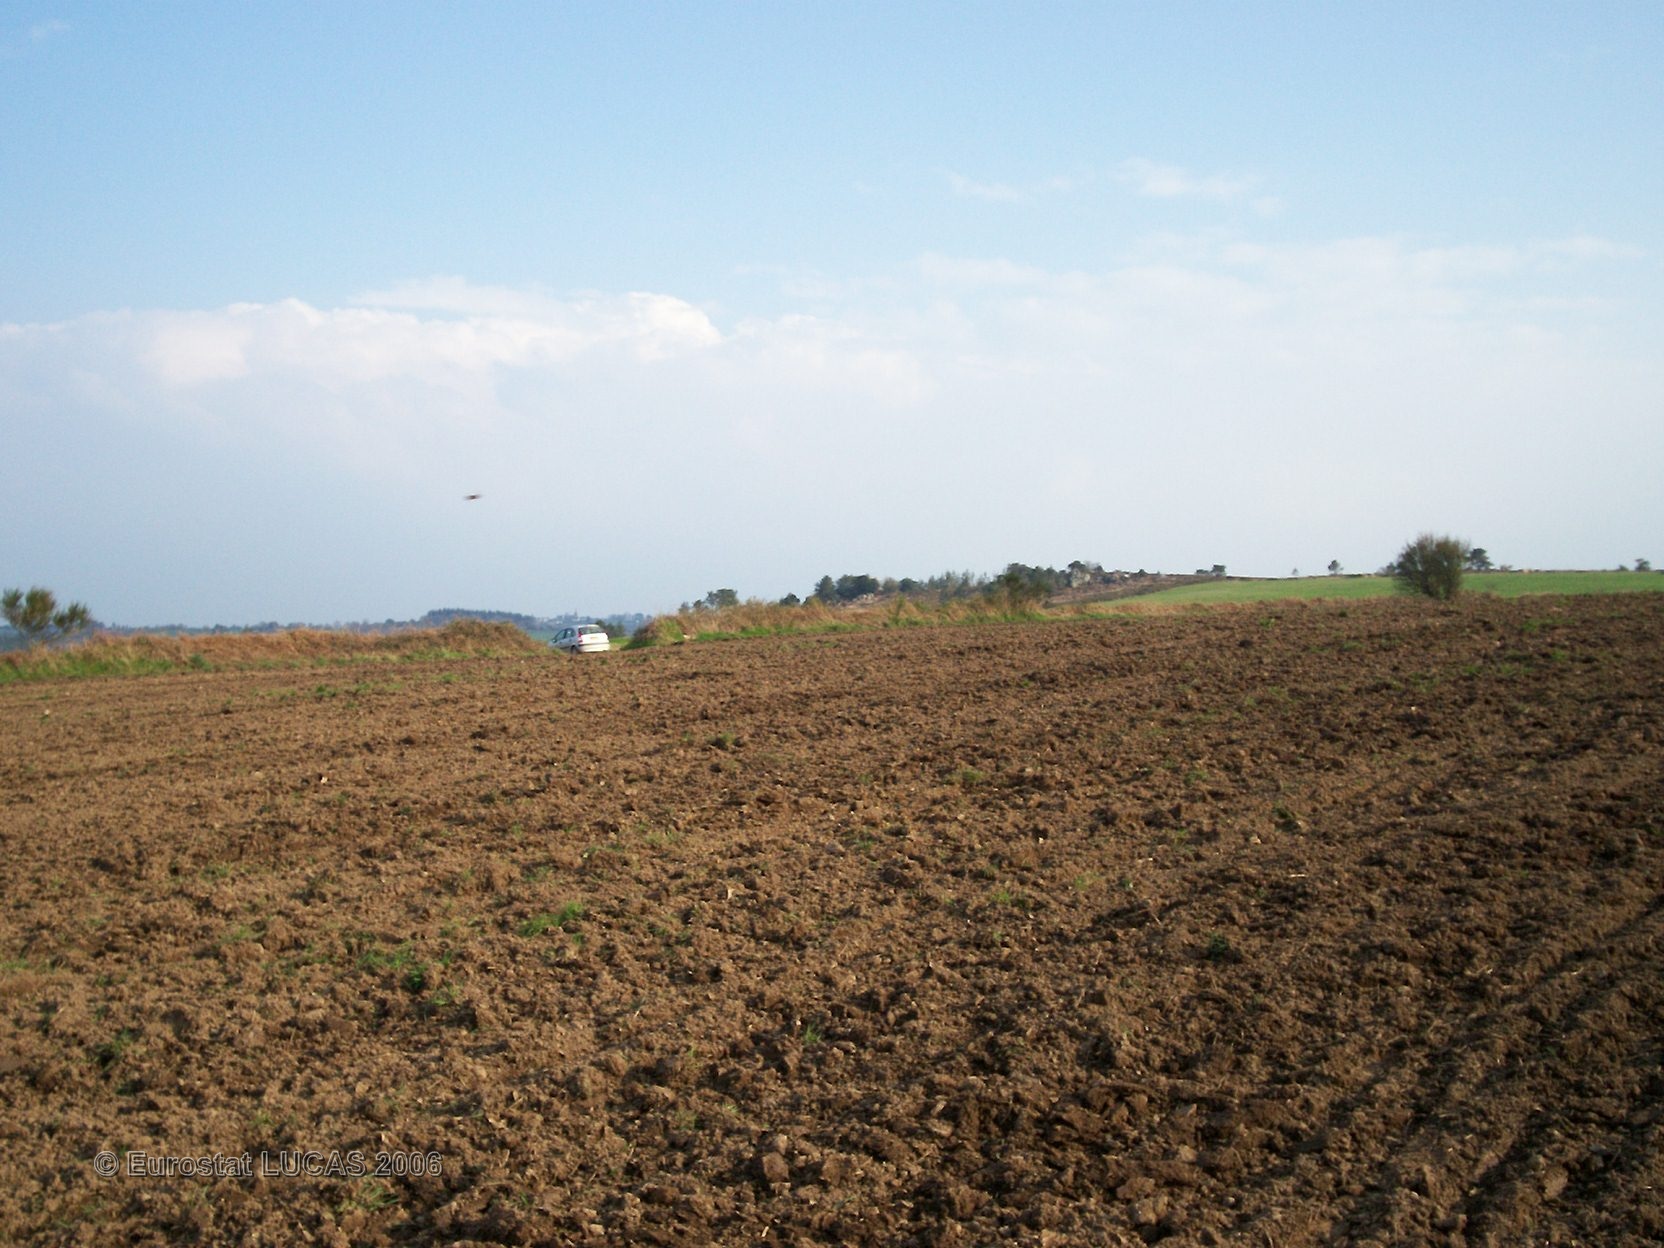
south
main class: Cropland
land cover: Maize
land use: Agriculture (excluding fallow land and kitchen gardens)
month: June
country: FR
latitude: 48.4581
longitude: -3.6998
